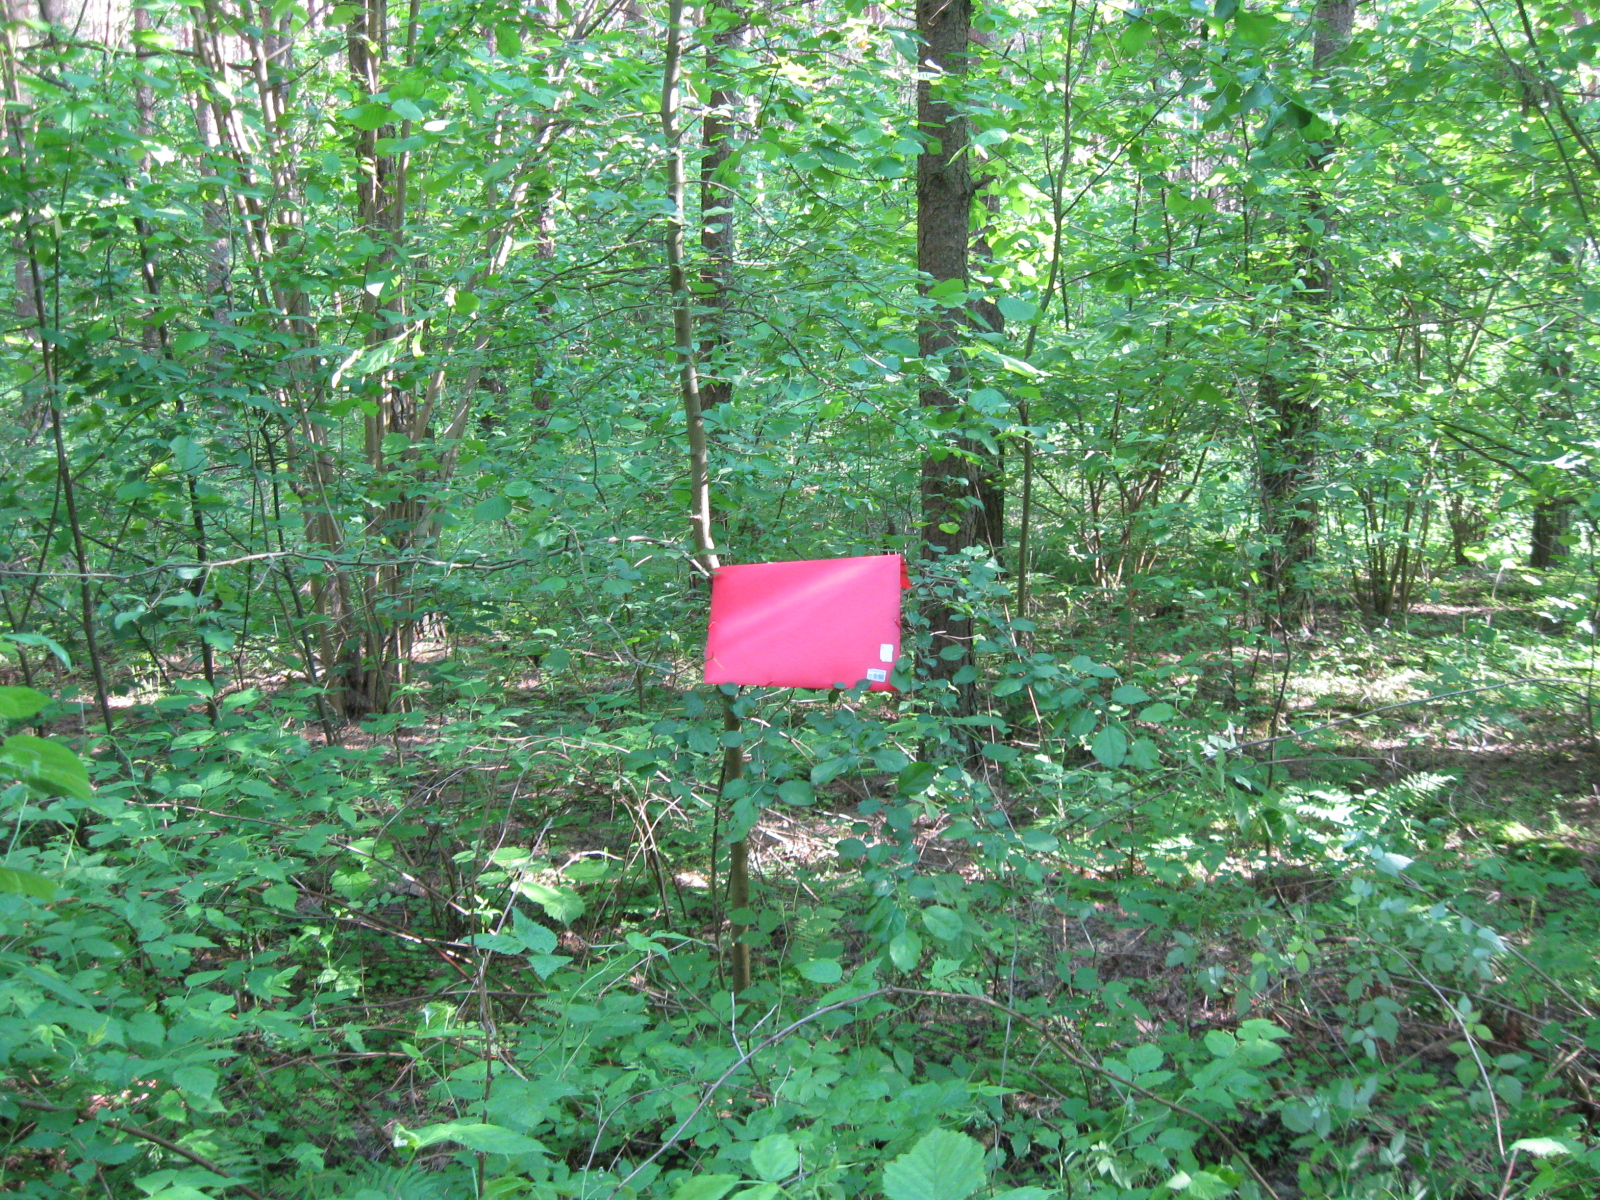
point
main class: Woodland
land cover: Pine dominated mixed woodland
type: hemiboreal forest and nemoral coniferous forest and mixed broadleaved-coniferous forest
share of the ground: > 75 %
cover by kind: coniferous forest trees 70 %, broadleaved forest trees 30 %
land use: Forestry
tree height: > 5 m
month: June
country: LT
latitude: 54.1166
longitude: 23.6867
